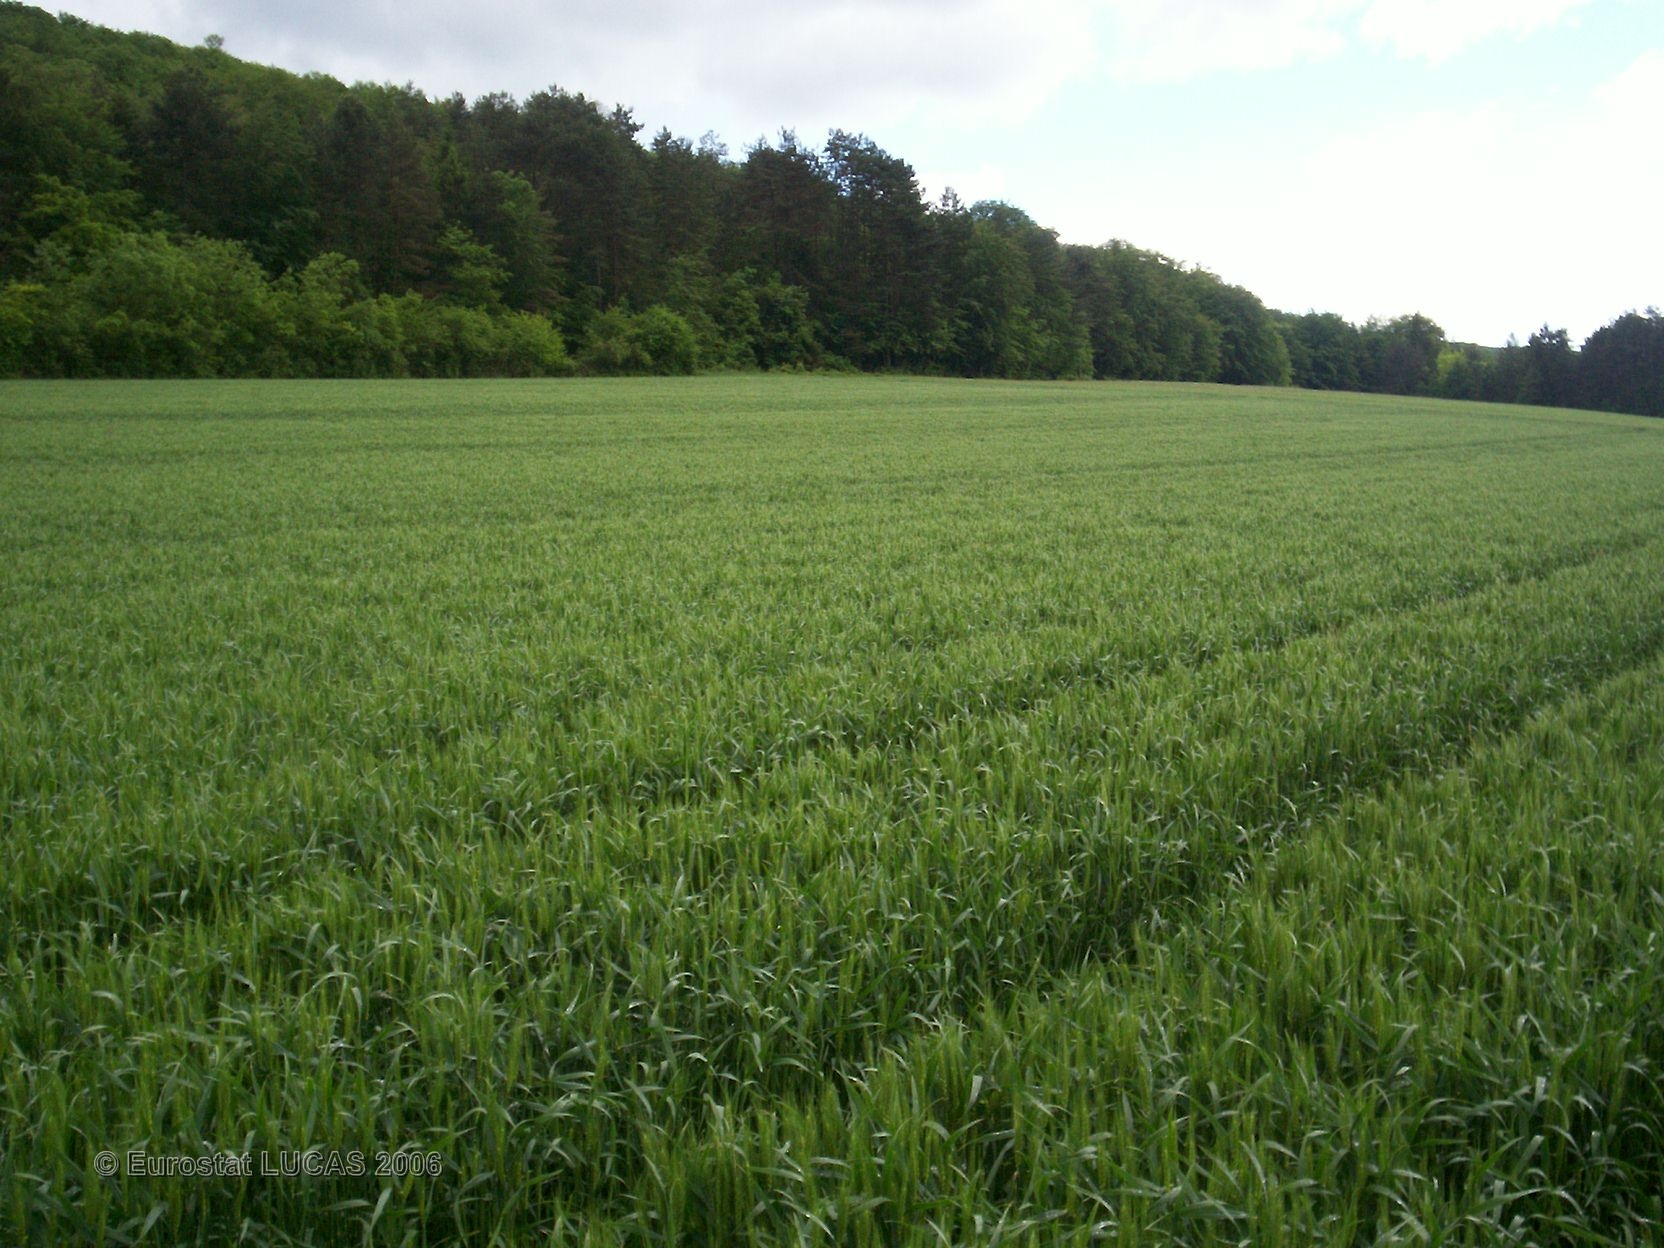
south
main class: Cropland
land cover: Barley
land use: Agriculture (excluding fallow land and kitchen gardens)
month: May
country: FR
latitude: 47.4981
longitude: 5.0221
